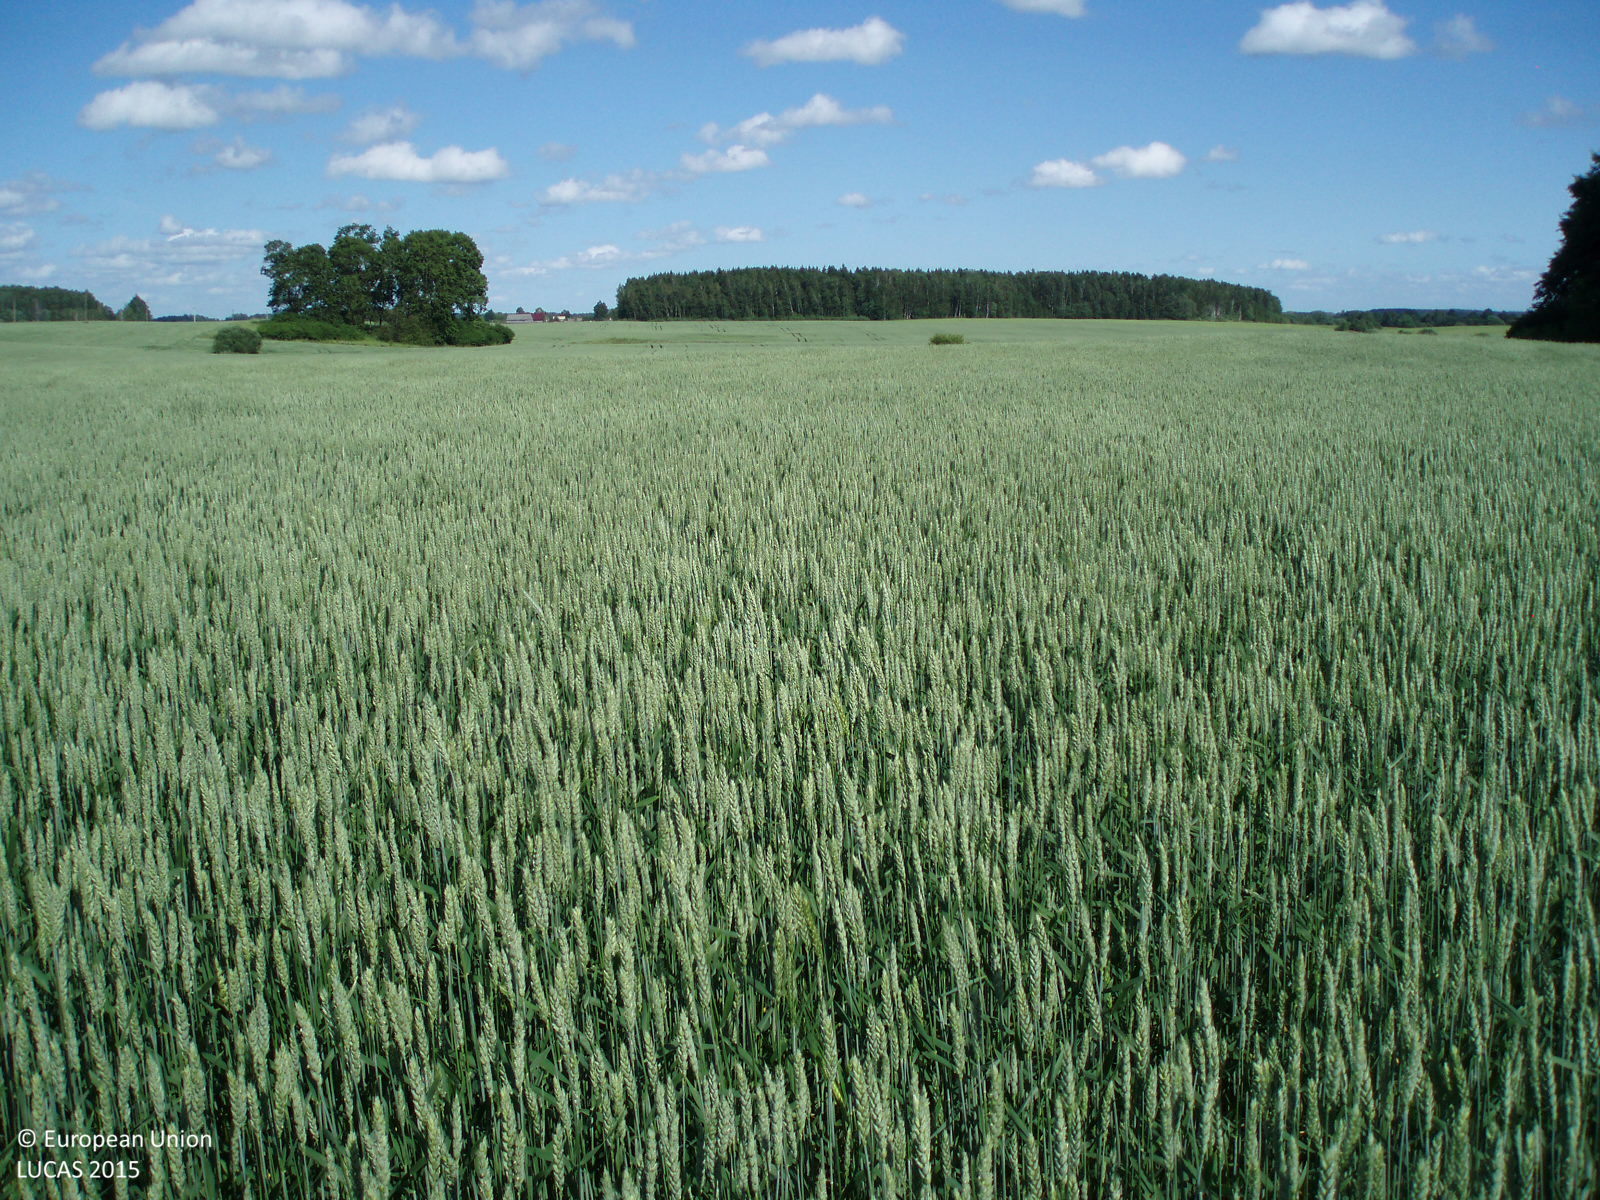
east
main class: Cropland
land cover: Common wheat
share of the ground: > 75 %
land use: Agriculture (excluding fallow land and kitchen gardens)
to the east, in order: Common wheat; Spontaneously vegetated surfaces; Ditches and canals; Spontaneously vegetated surfaces; Common wheat
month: July
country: LT
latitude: 56.0003
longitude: 22.4208
